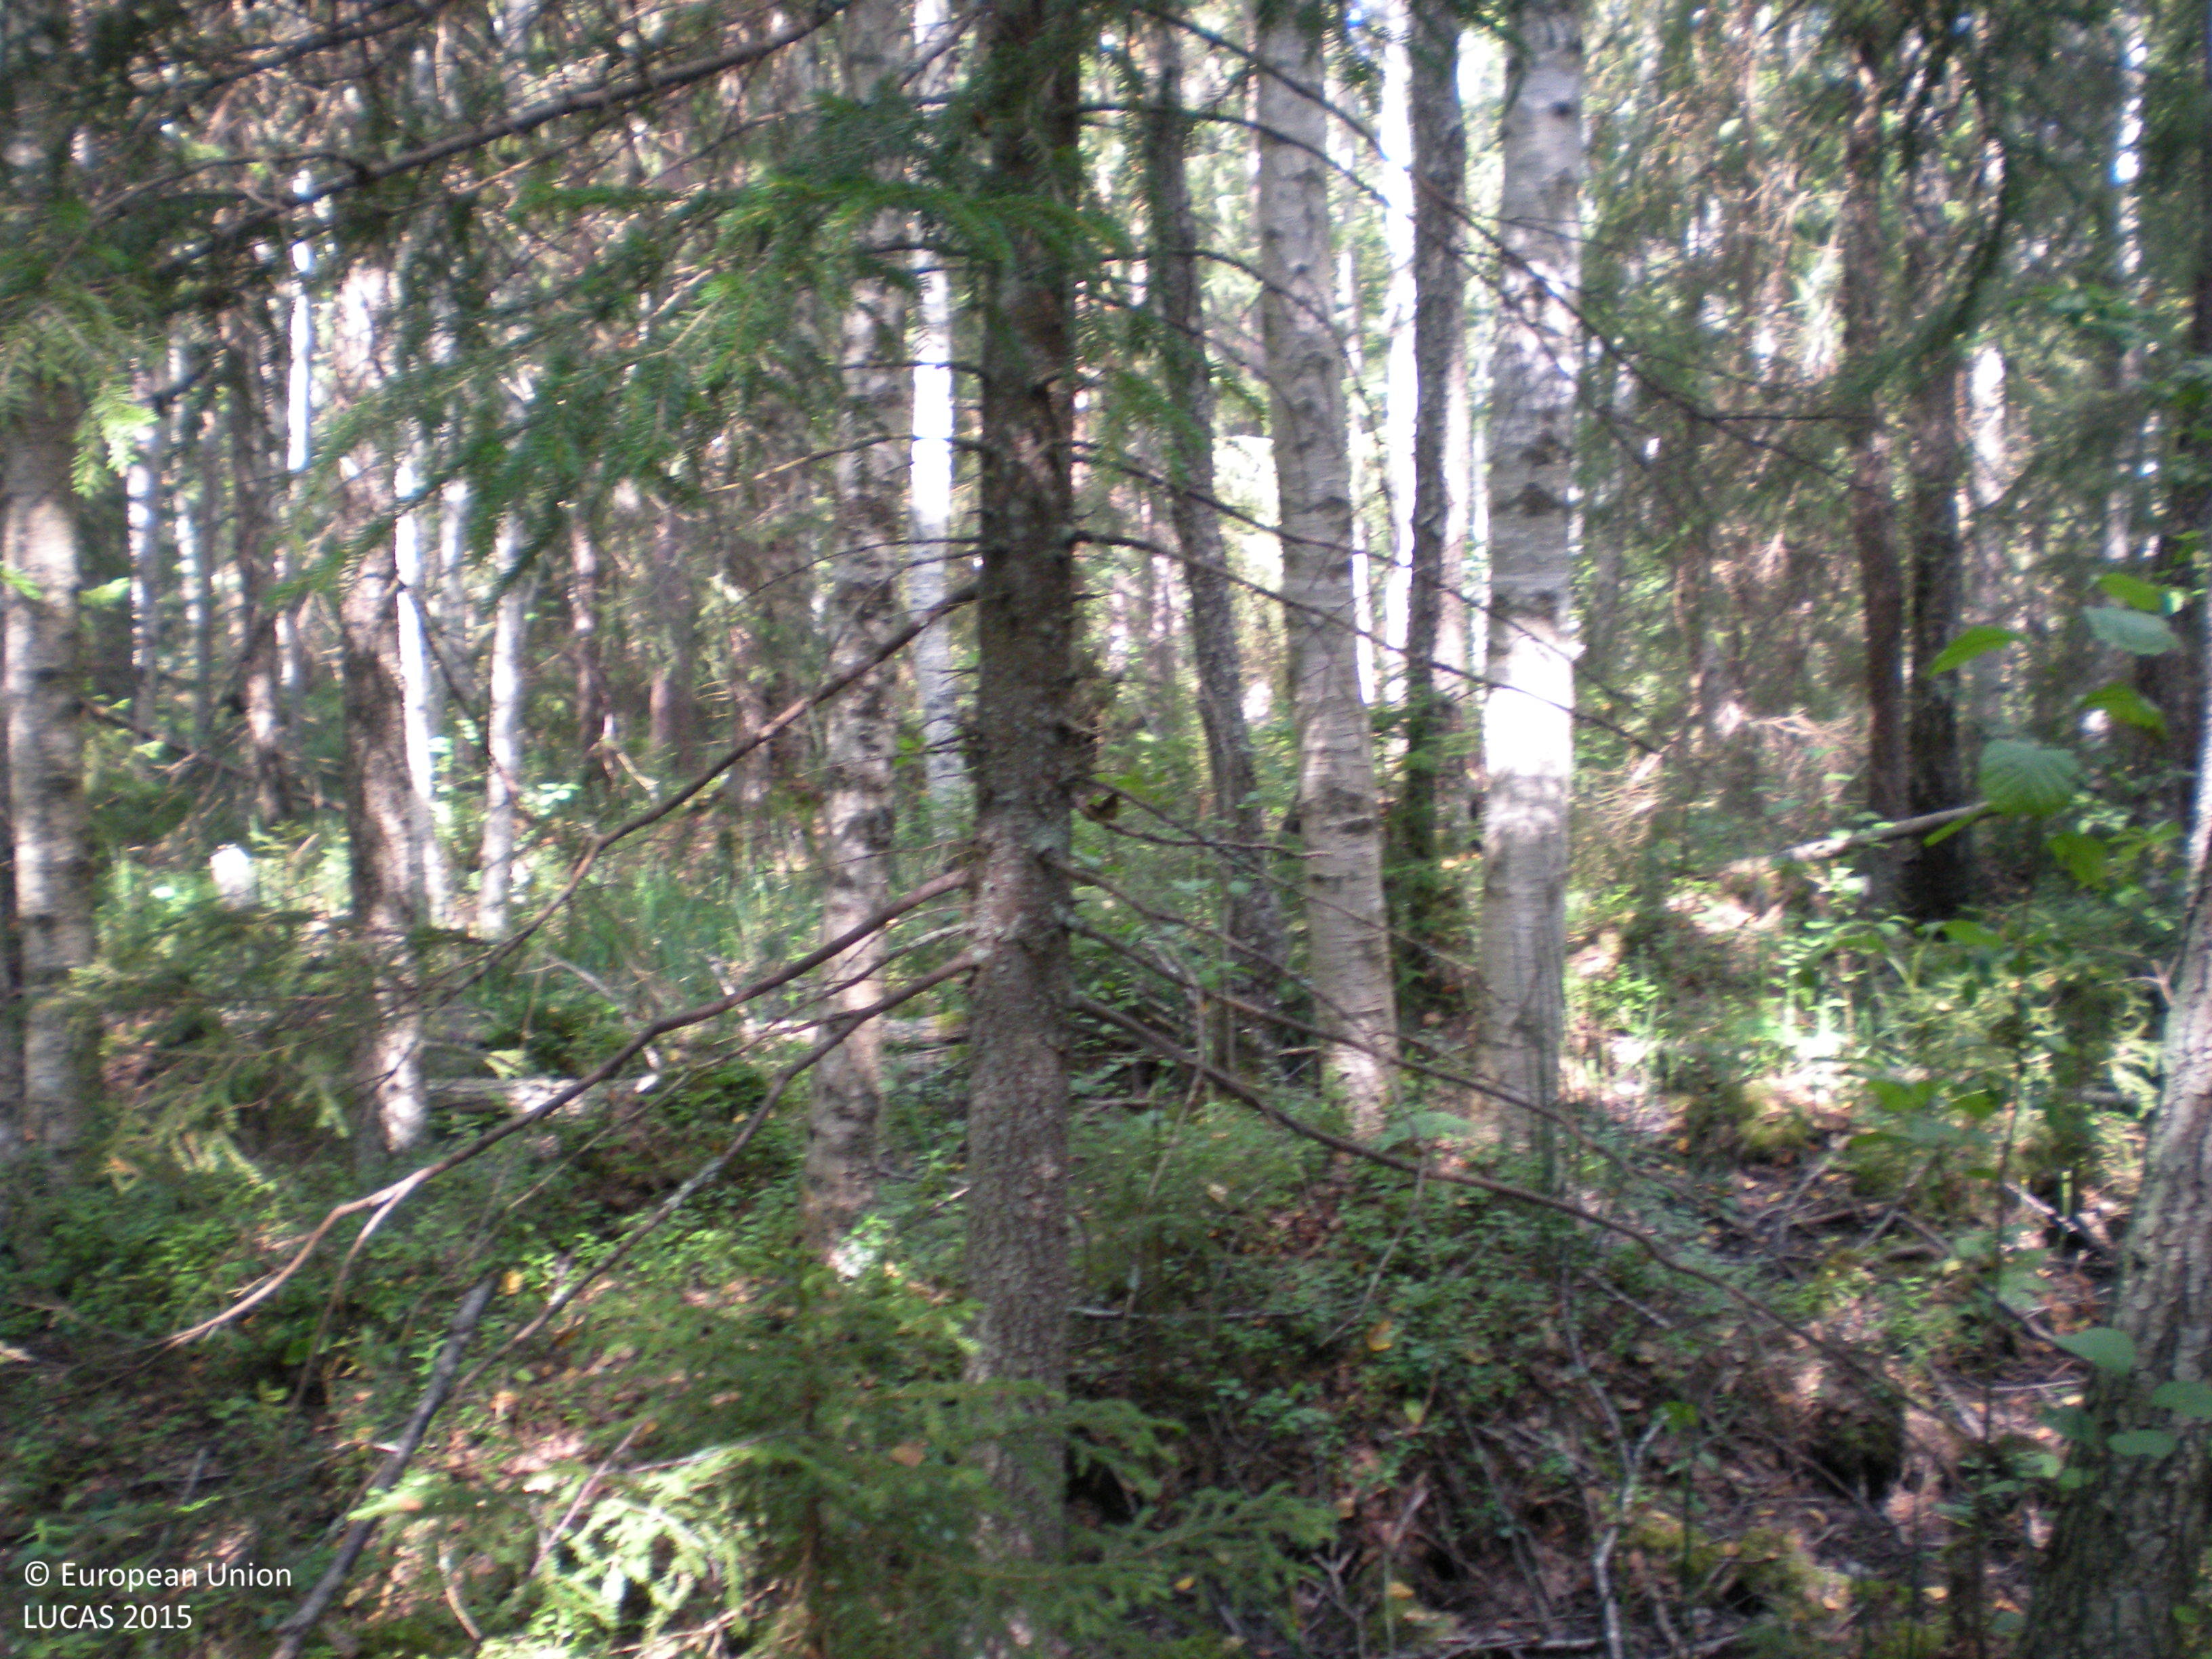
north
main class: Woodland
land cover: Spruce dominated mixed woodland
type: boreal forest
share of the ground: 50 - 75 %
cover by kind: coniferous forest trees 50 %, broadleaved forest trees 20 %, herbaceous plants 20 %, shrubs 5 %, lichens and mosses 5 %
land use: Forestry
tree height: > 5 m
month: August
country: SE
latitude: 60.6633
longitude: 17.2535
